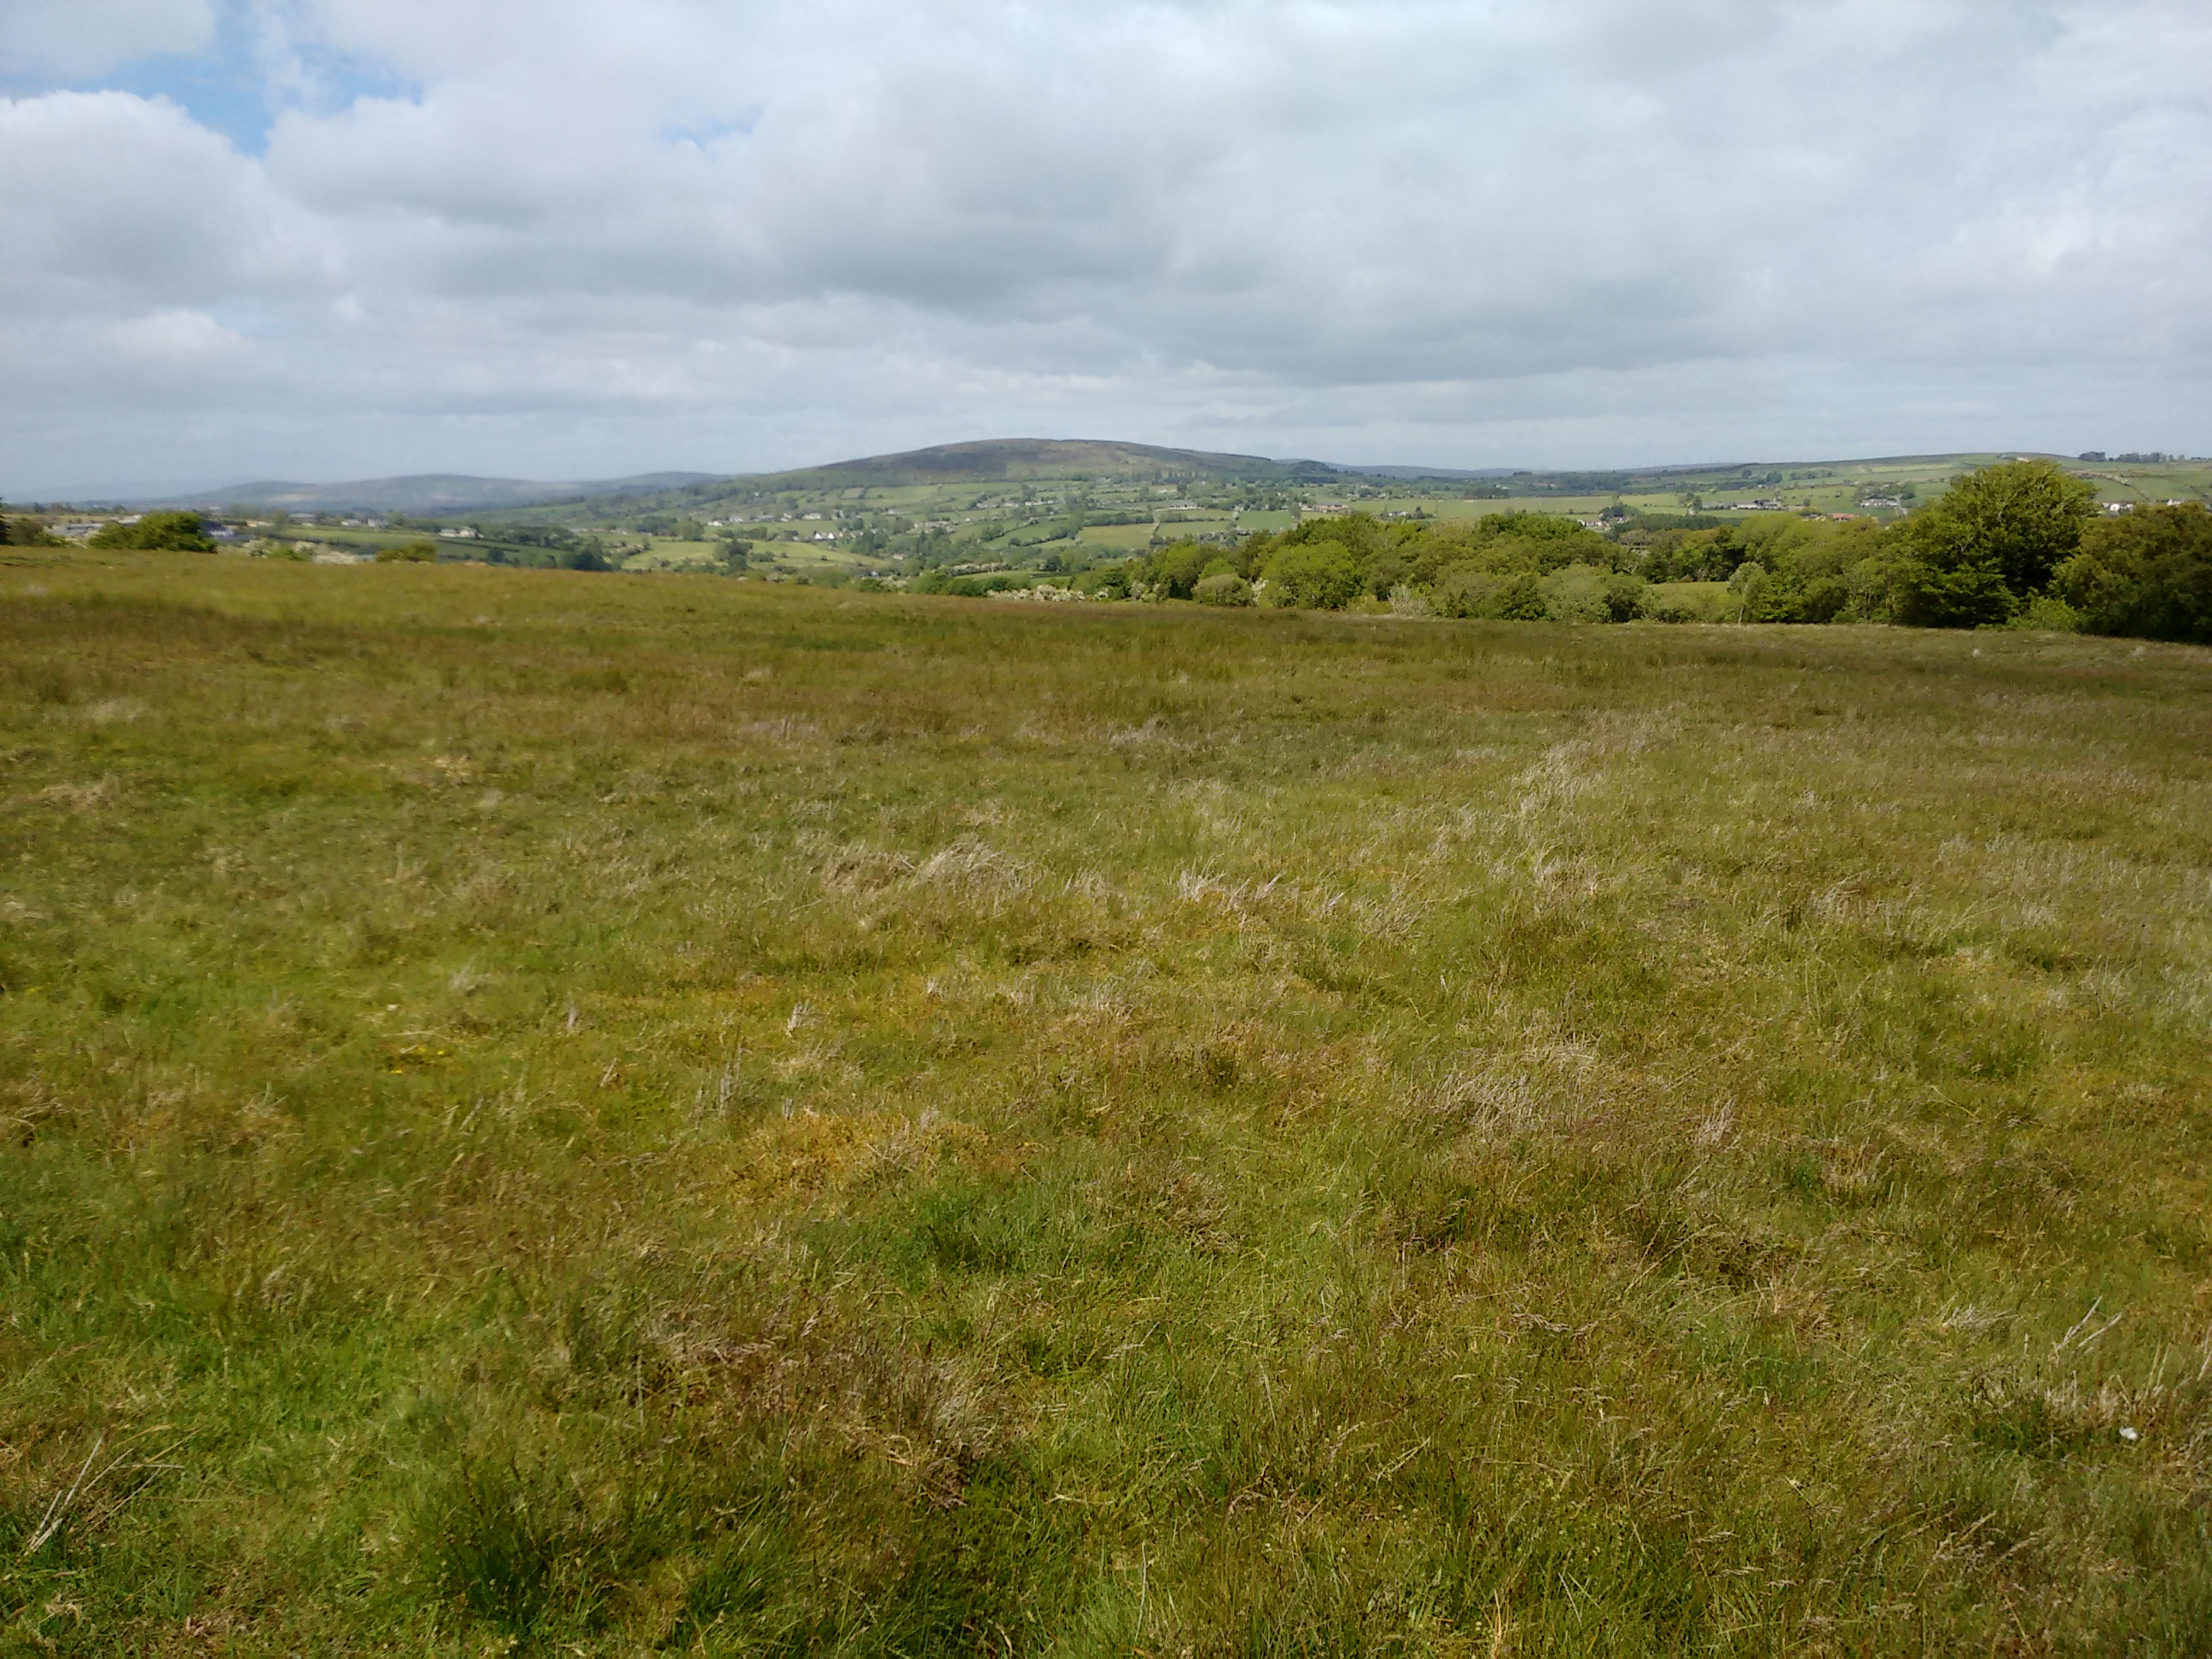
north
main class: Grassland
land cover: Grassland without tree/shrub cover
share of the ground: > 75 %
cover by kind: herbaceous plants 100 %
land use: Agriculture (excluding fallow land and kitchen gardens)
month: June
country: GB
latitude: 54.8466
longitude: -7.0691
